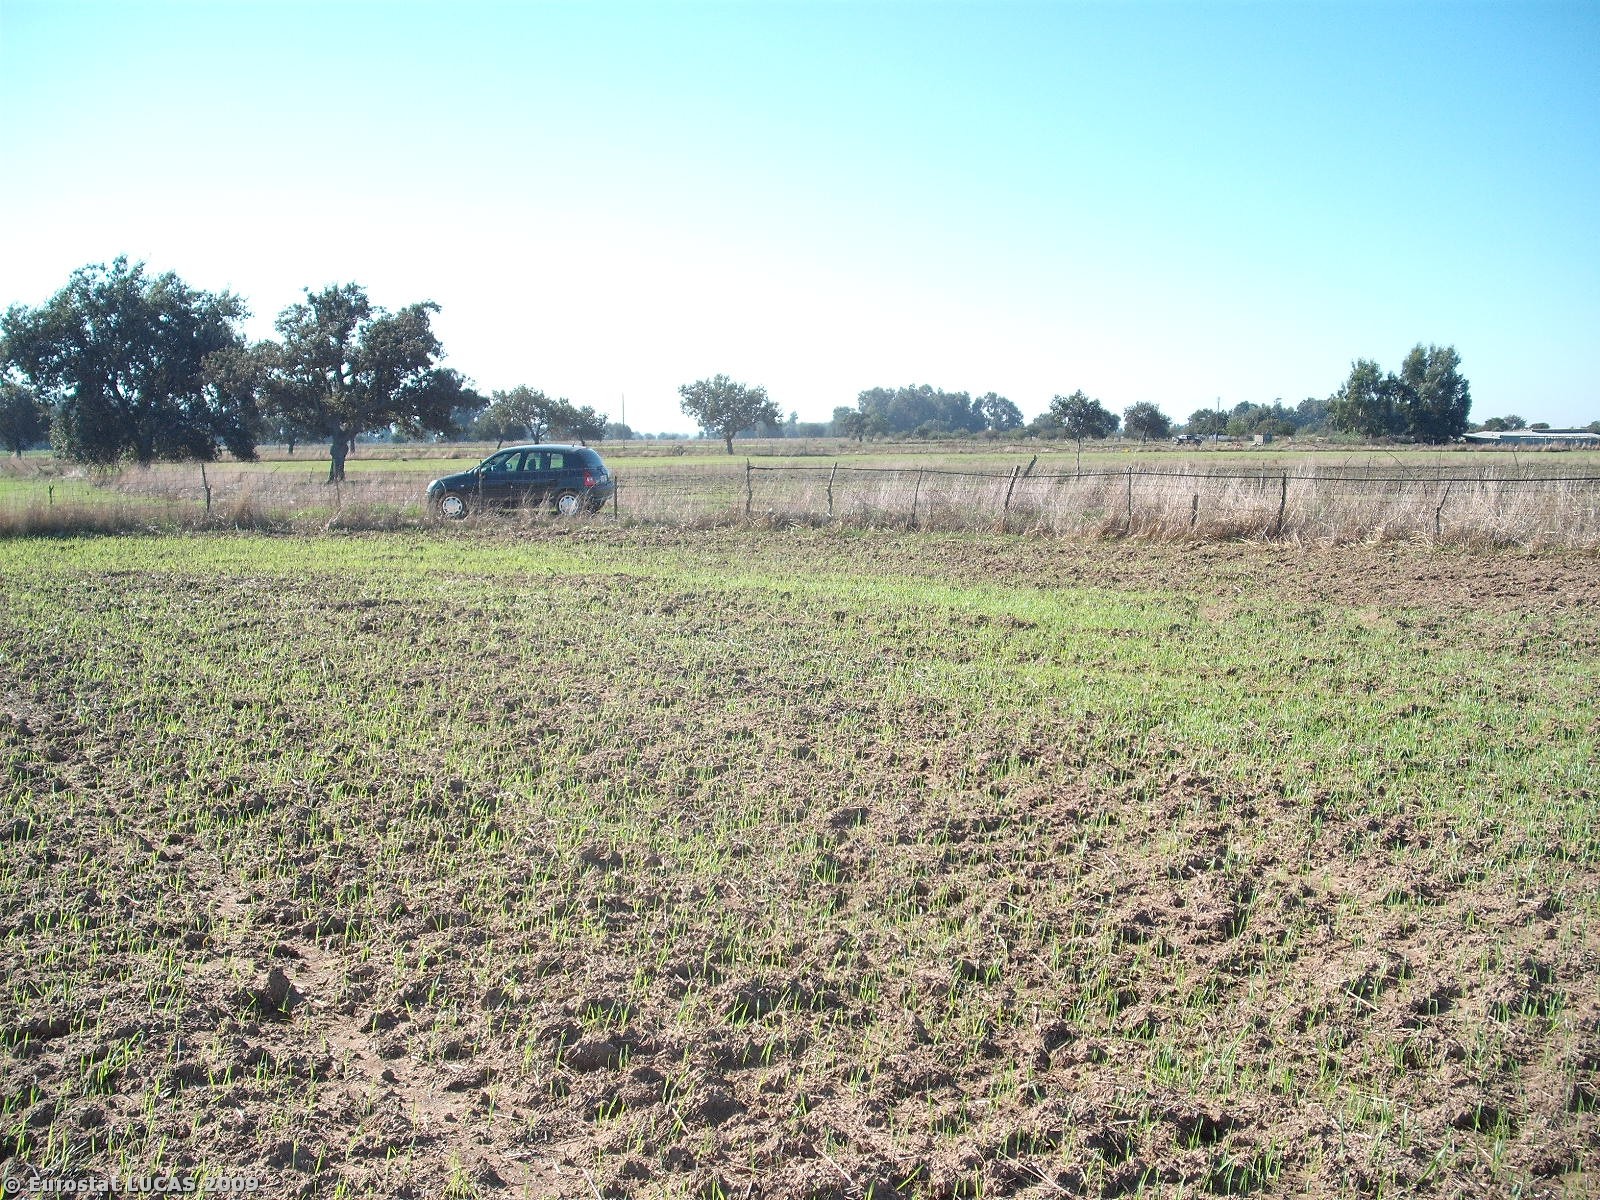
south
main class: Cropland
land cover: Mixed cereals for fodder
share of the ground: < 10 %
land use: Agriculture (excluding fallow land and kitchen gardens)
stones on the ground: < 10 %
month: October
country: GR
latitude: 38.1505
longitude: 21.4559
